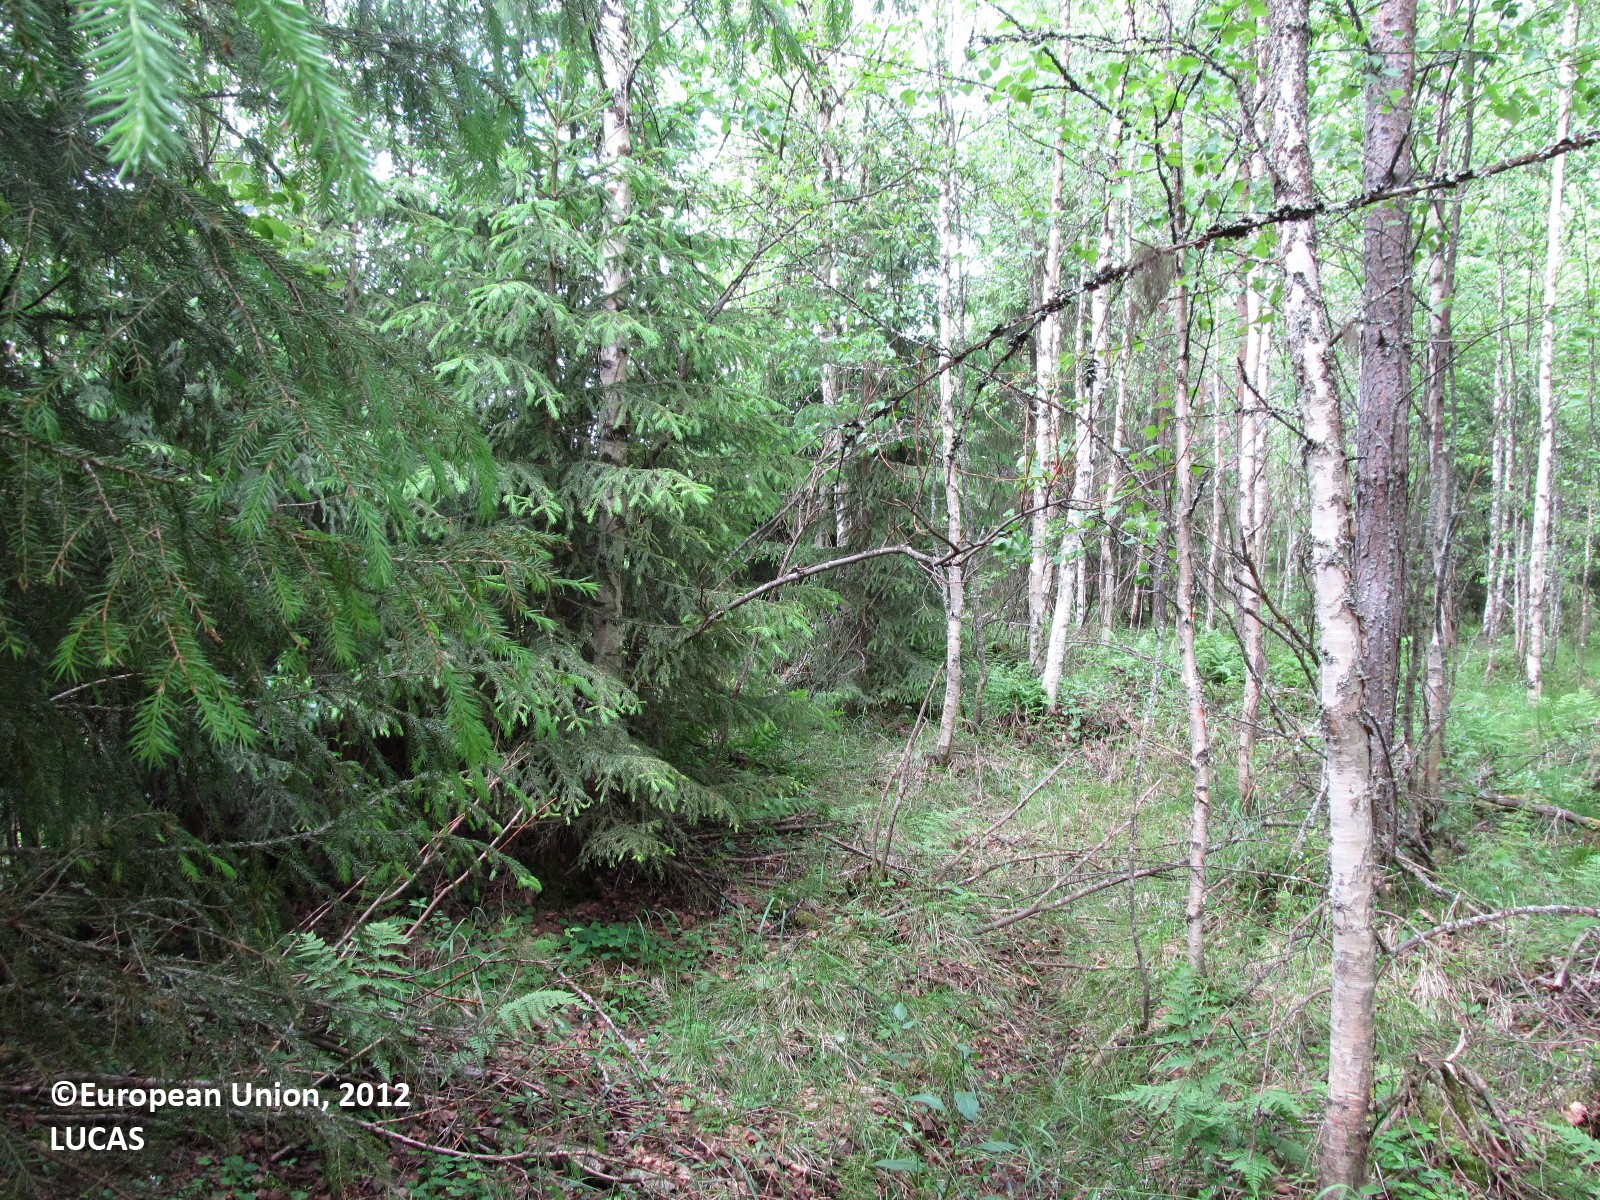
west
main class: Woodland
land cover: Spruce dominated mixed woodland
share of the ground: 50 - 75 %
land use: Forestry
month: June
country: FI
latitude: 63.2407
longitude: 27.7040
